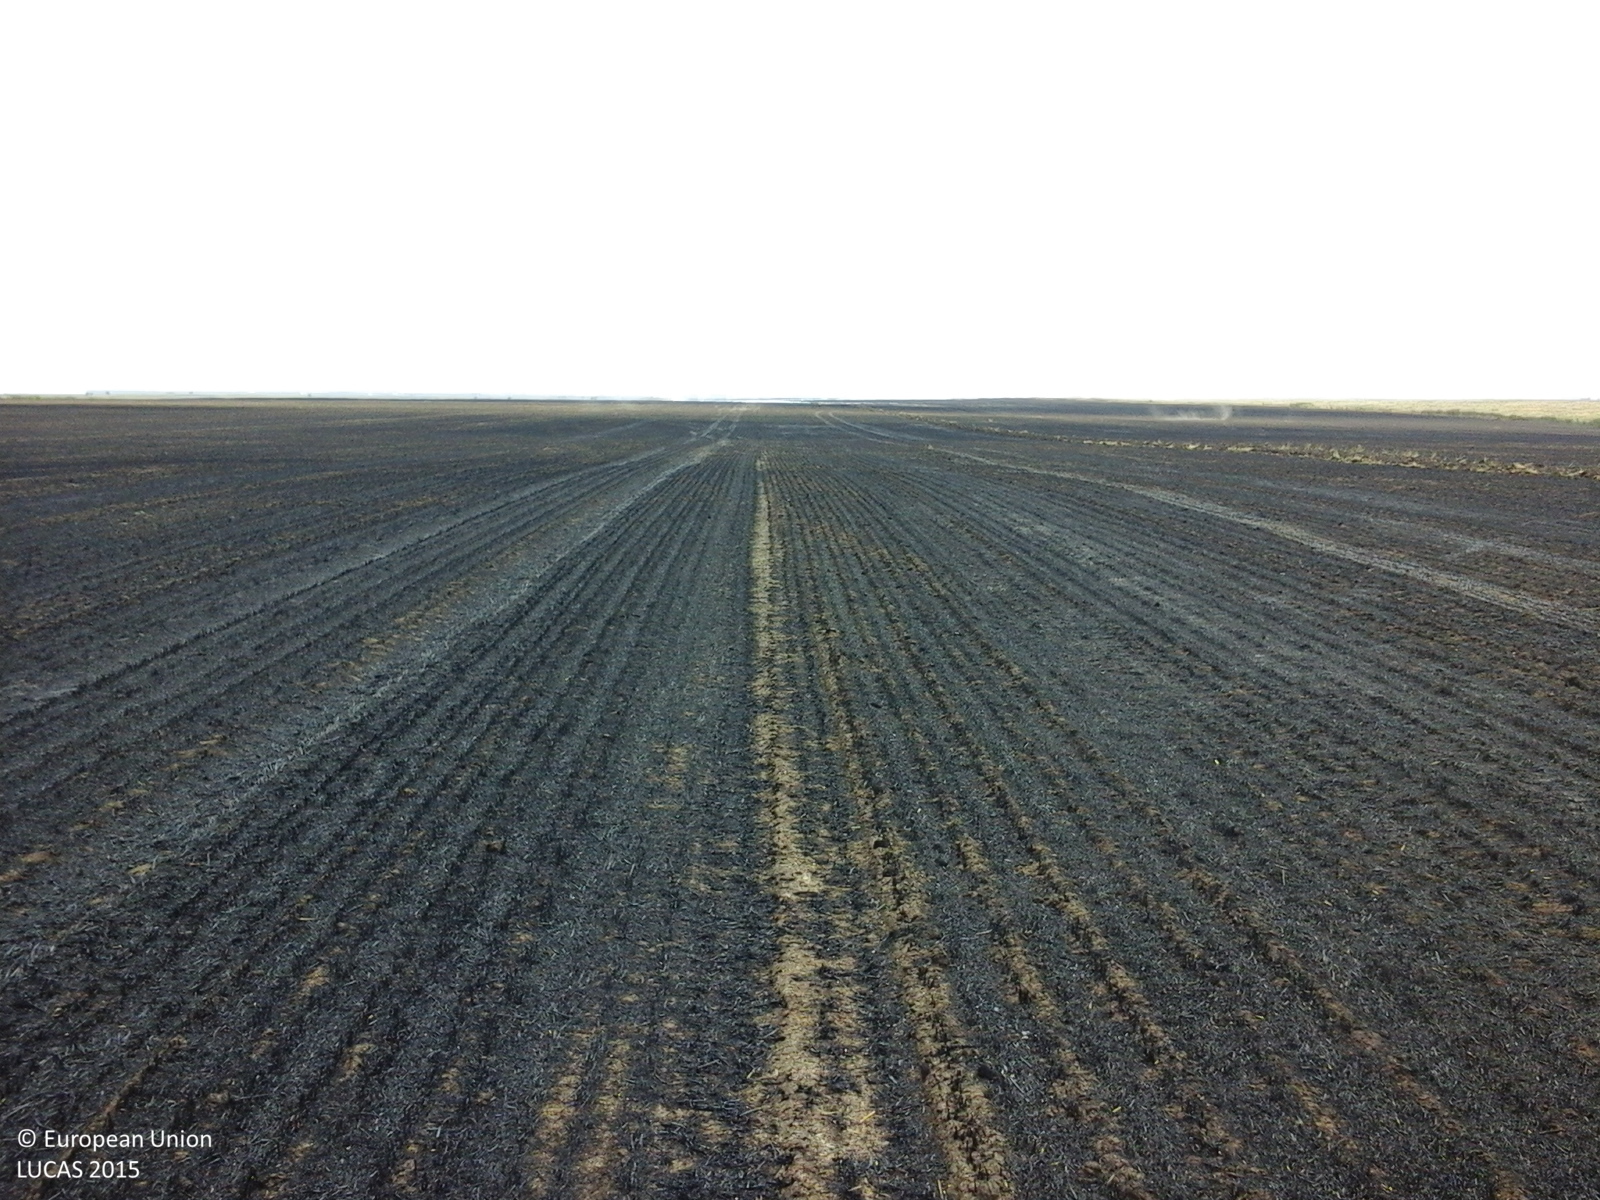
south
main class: Cropland
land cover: Common wheat
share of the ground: < 10 %
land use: Agriculture (excluding fallow land and kitchen gardens)
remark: Burnt area
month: July
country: RO
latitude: 44.5139
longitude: 27.5683
